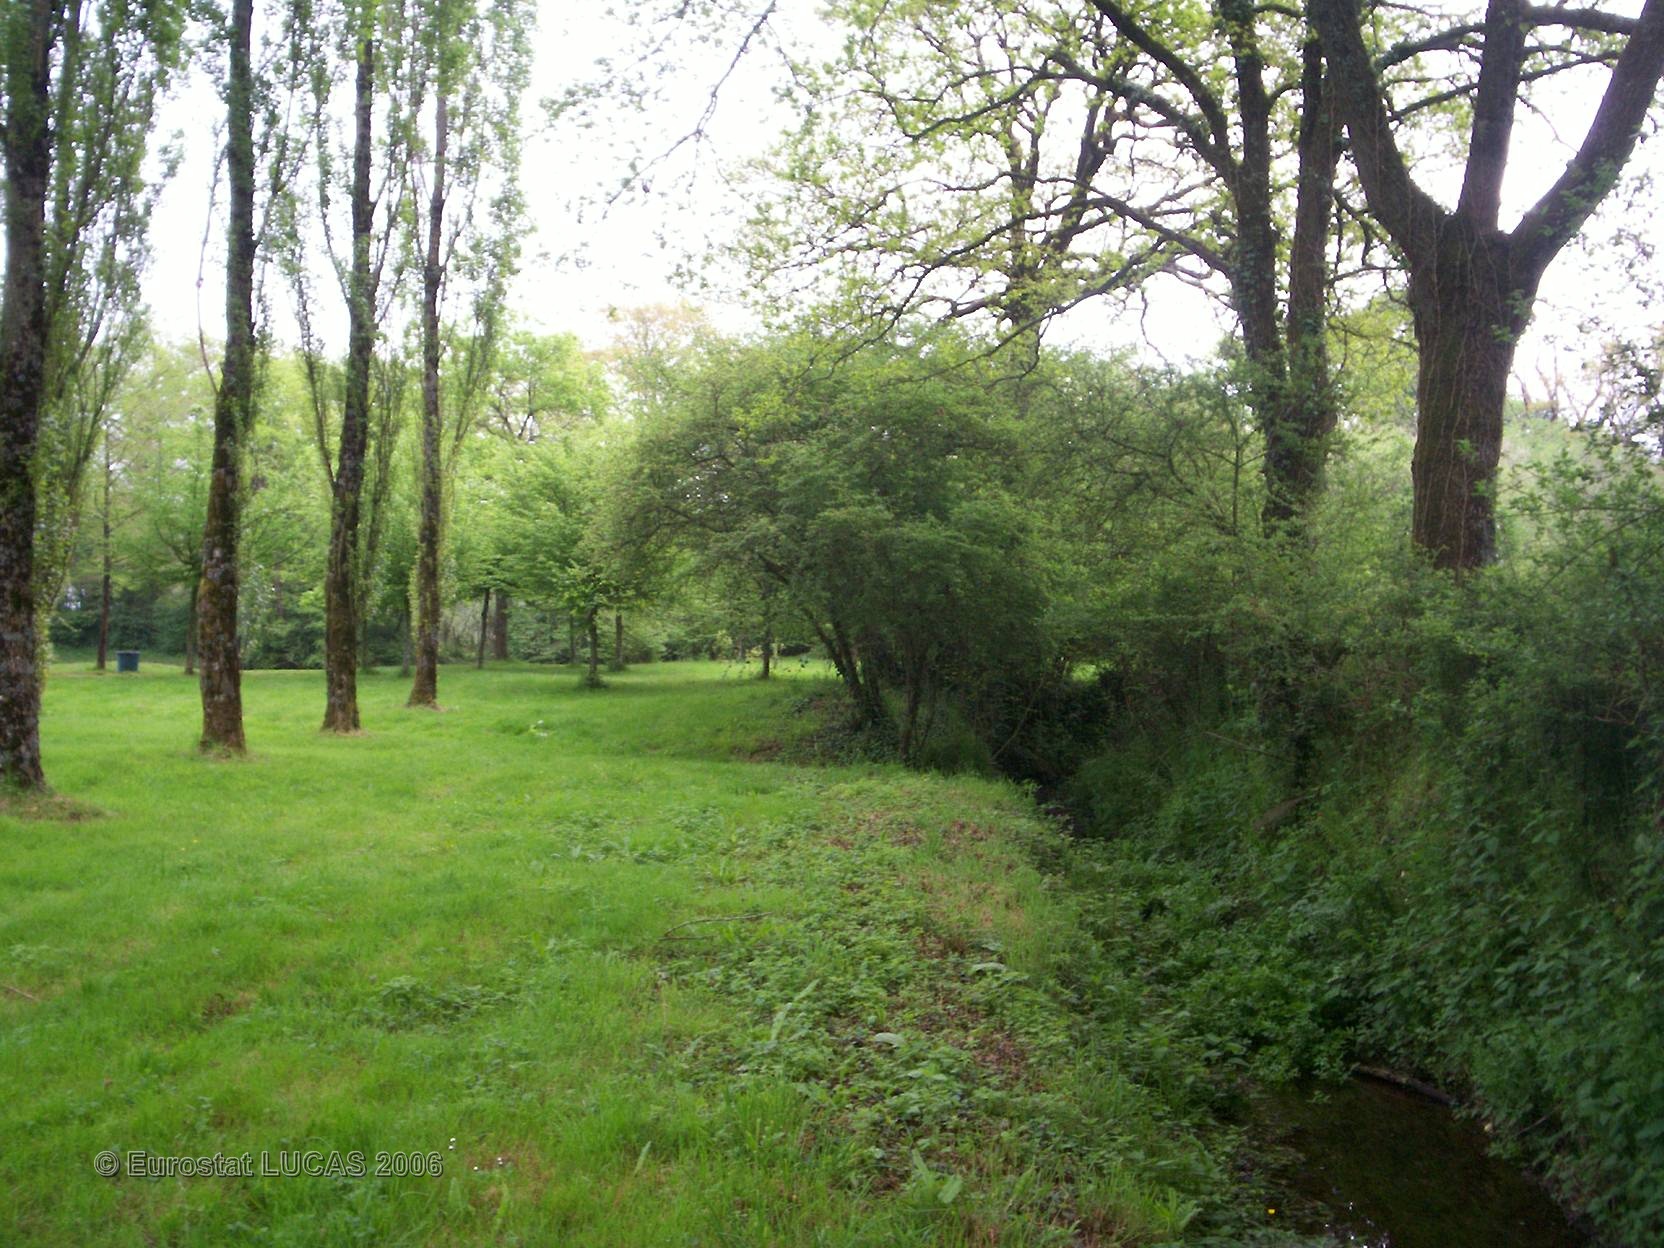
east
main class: Grassland
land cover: Grassland with sparse tree/shrub cover
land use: Amenities, museums, leisure
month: May
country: FR
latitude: 46.8297
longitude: -1.0594
